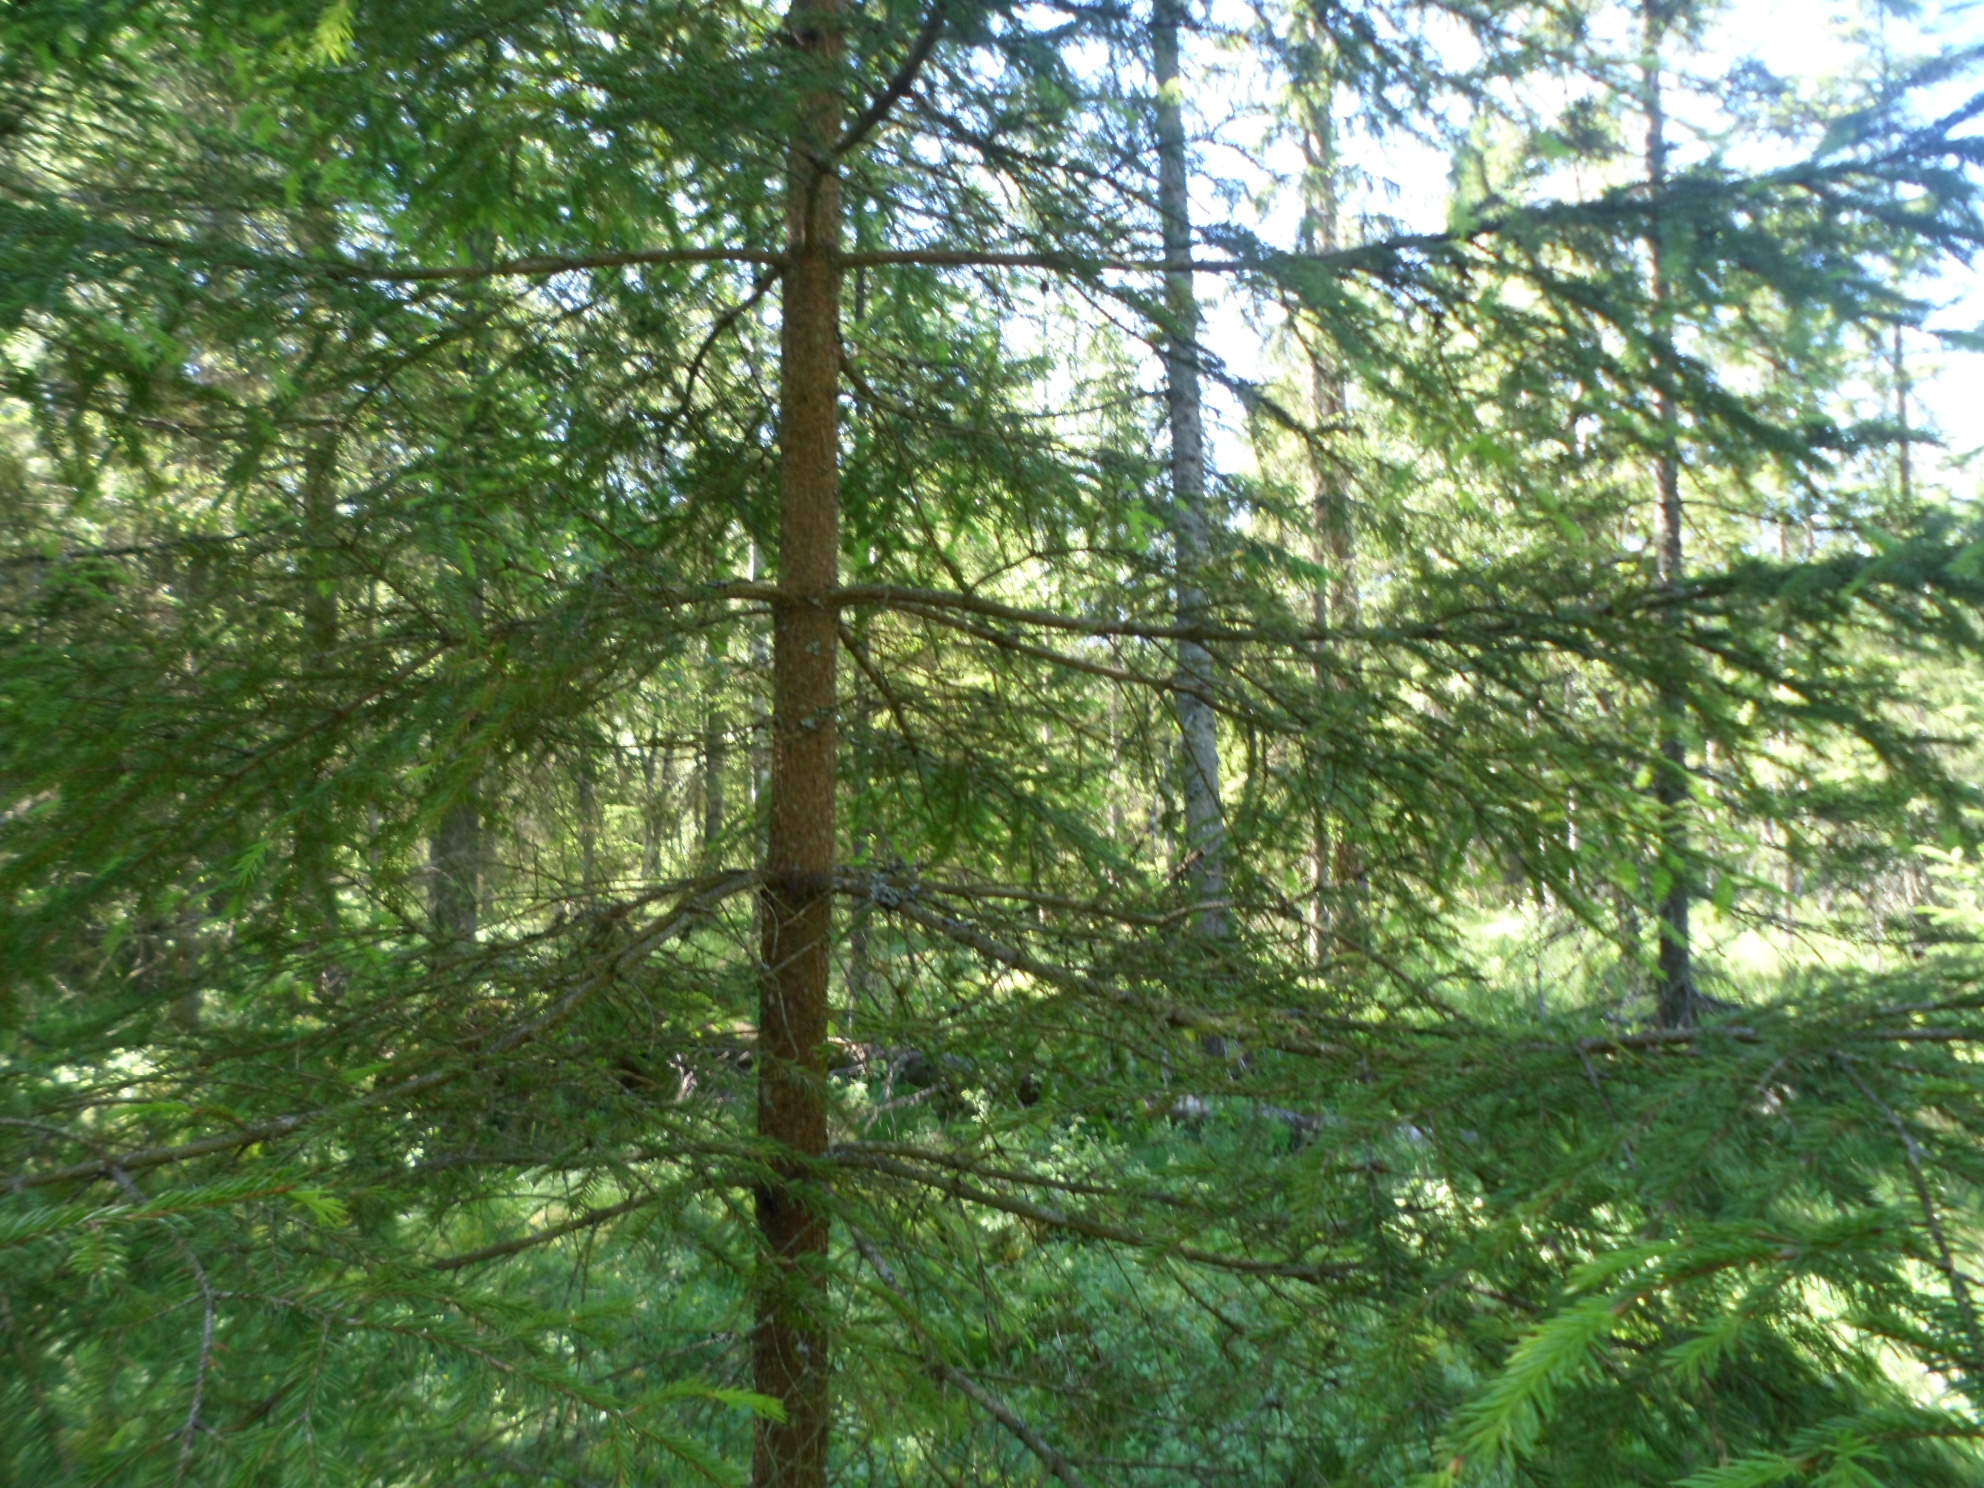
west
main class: Woodland
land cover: Spruce dominated coniferous woodland
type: boreal forest
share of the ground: 50 - 75 %
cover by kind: coniferous forest trees 50 %, shrubs 30 %, lichens and mosses 10 %, broadleaved forest trees 5 %, herbaceous plants 5 %
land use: Forestry
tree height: > 5 m
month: July
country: SE
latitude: 57.4940
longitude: 14.5506
